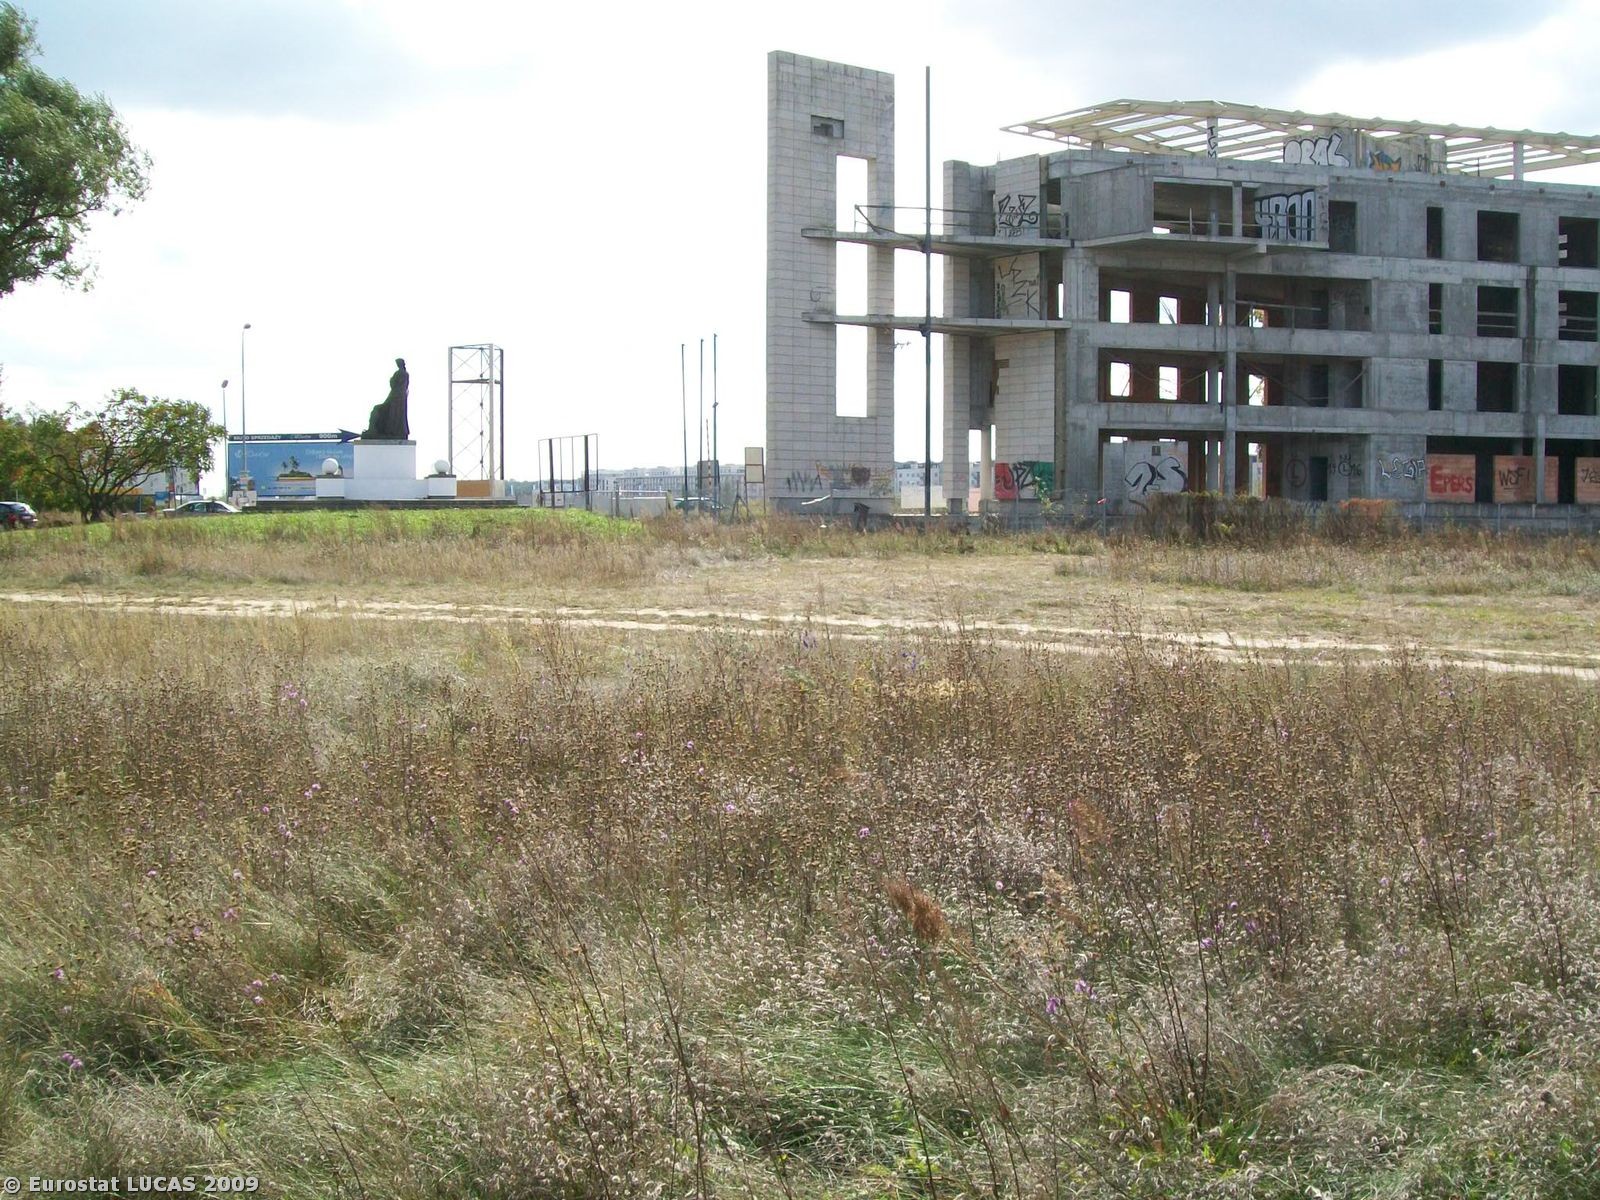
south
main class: Grassland
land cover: Grassland without tree/shrub cover
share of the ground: > 75 %
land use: Unused
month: September
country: PL
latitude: 52.1653
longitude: 21.0834
